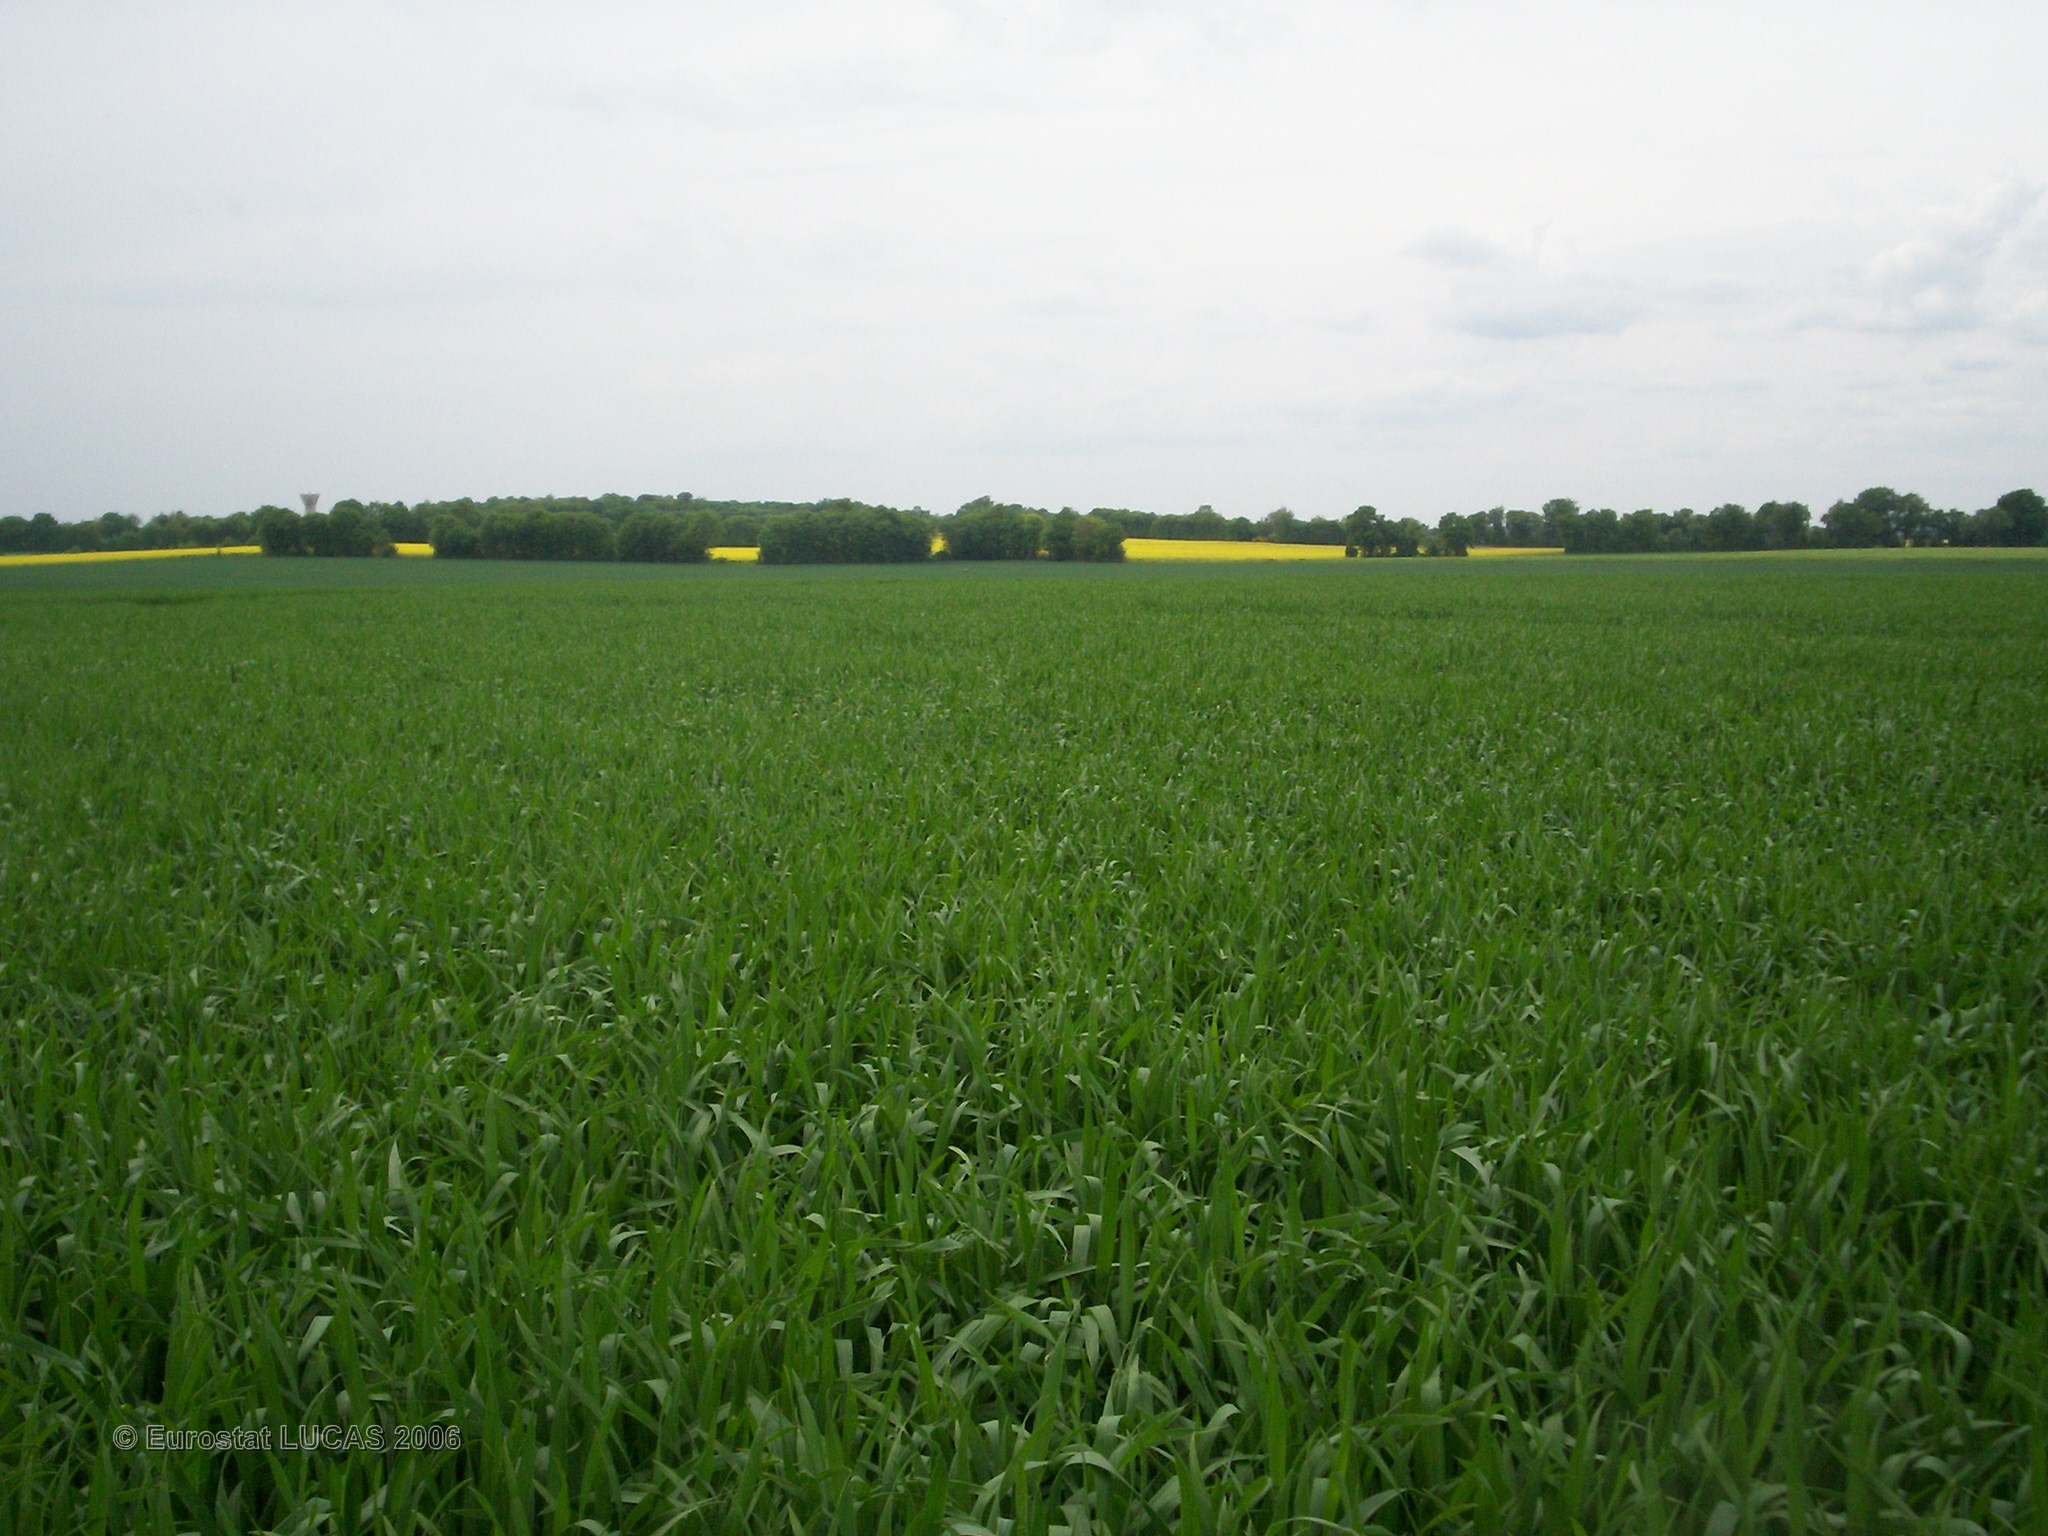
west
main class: Cropland
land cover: Common wheat
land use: Agriculture (excluding fallow land and kitchen gardens)
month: May
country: FR
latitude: 47.6955
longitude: 3.0251
